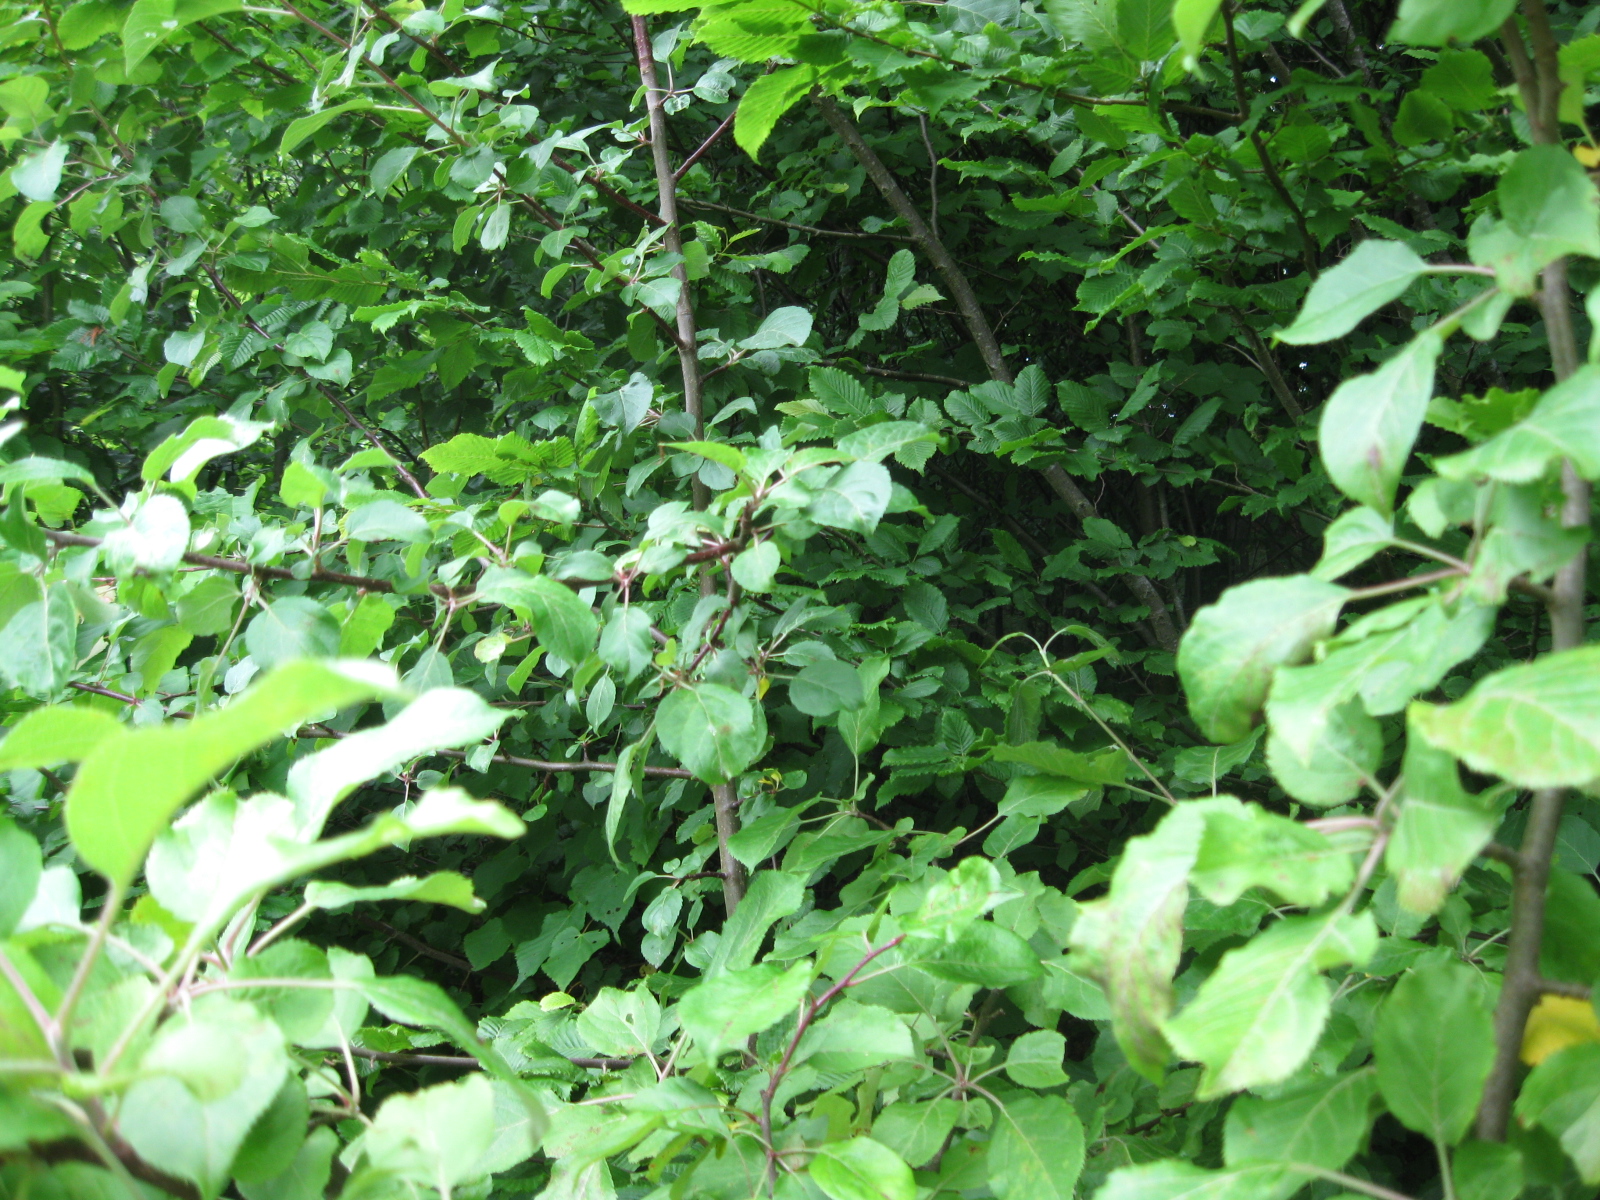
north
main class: Woodland
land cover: Broadleaved woodland
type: non-riverine alder, birch or aspen forest
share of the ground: > 75 %
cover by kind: broadleaved forest trees 85 %, herbaceous plants 10 %, lichens and mosses 5 %
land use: Semi-natural and natural areas not in use
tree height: > 5 m
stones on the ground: < 10 %
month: June
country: LT
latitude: 55.2510
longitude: 23.4988
